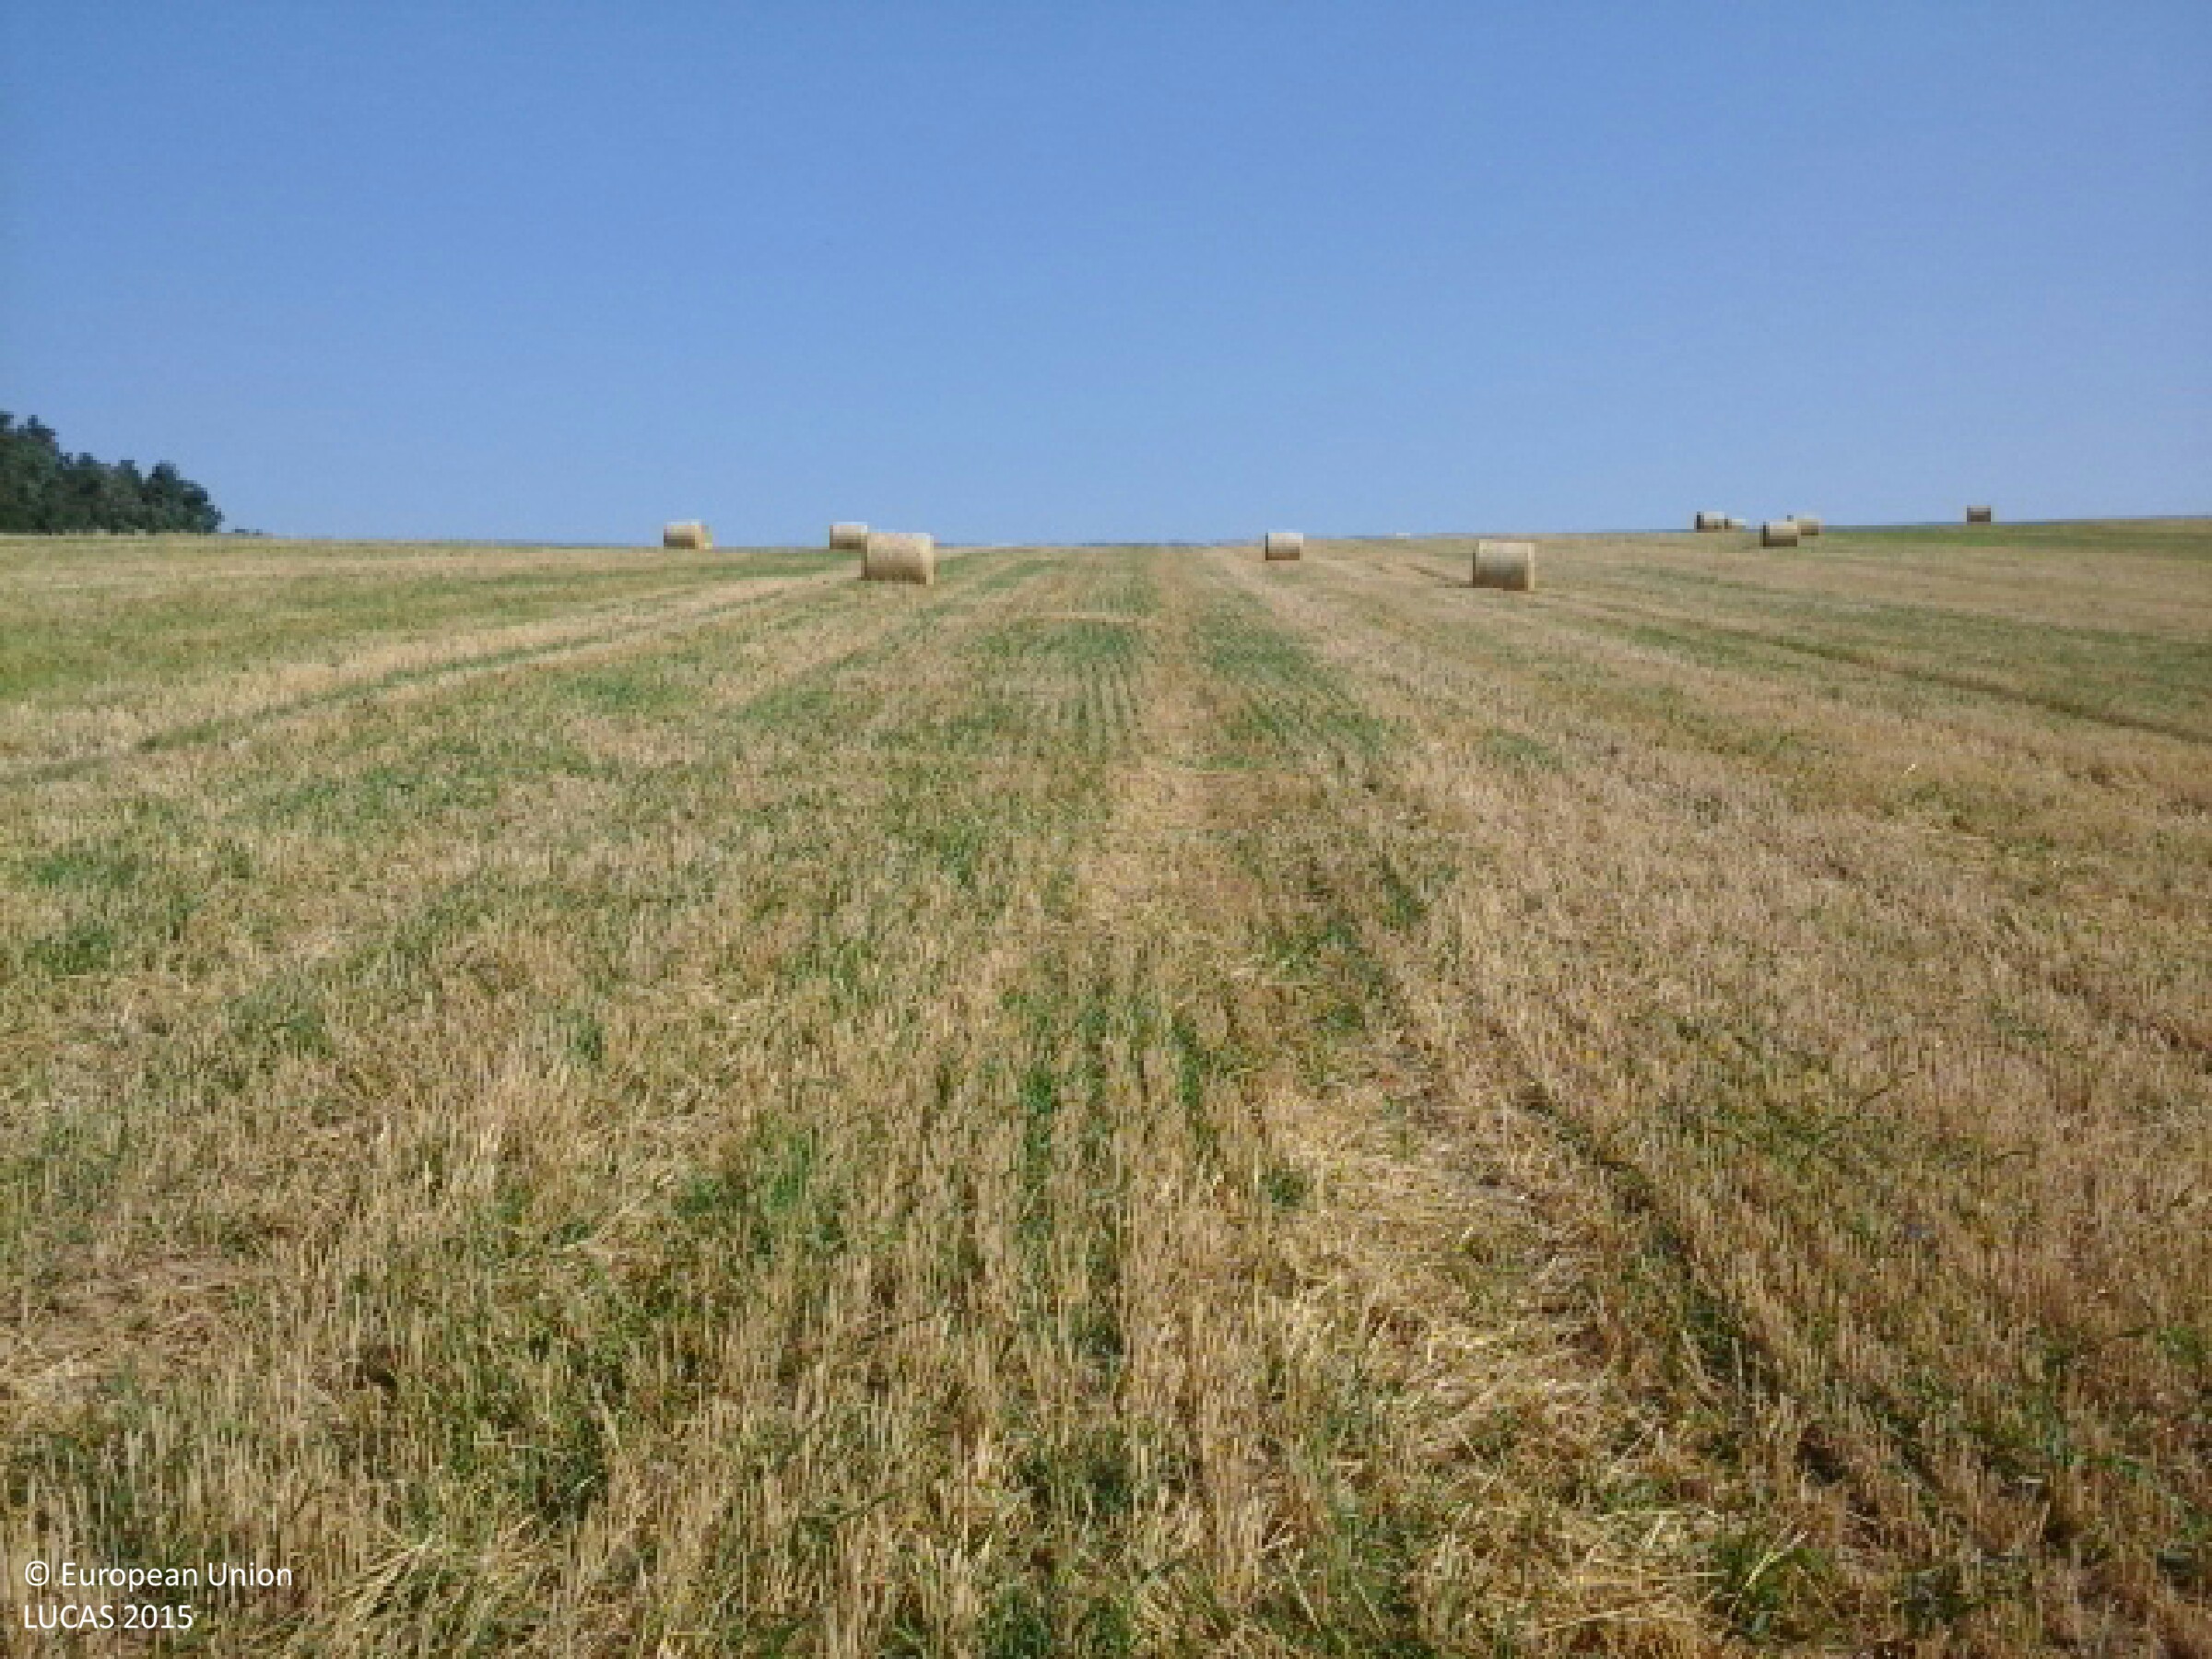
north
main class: Cropland
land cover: Triticale
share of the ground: 10 - 25 %
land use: Agriculture (excluding fallow land and kitchen gardens)
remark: Harvested field
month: July
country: HU
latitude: 48.5198
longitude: 21.0485
